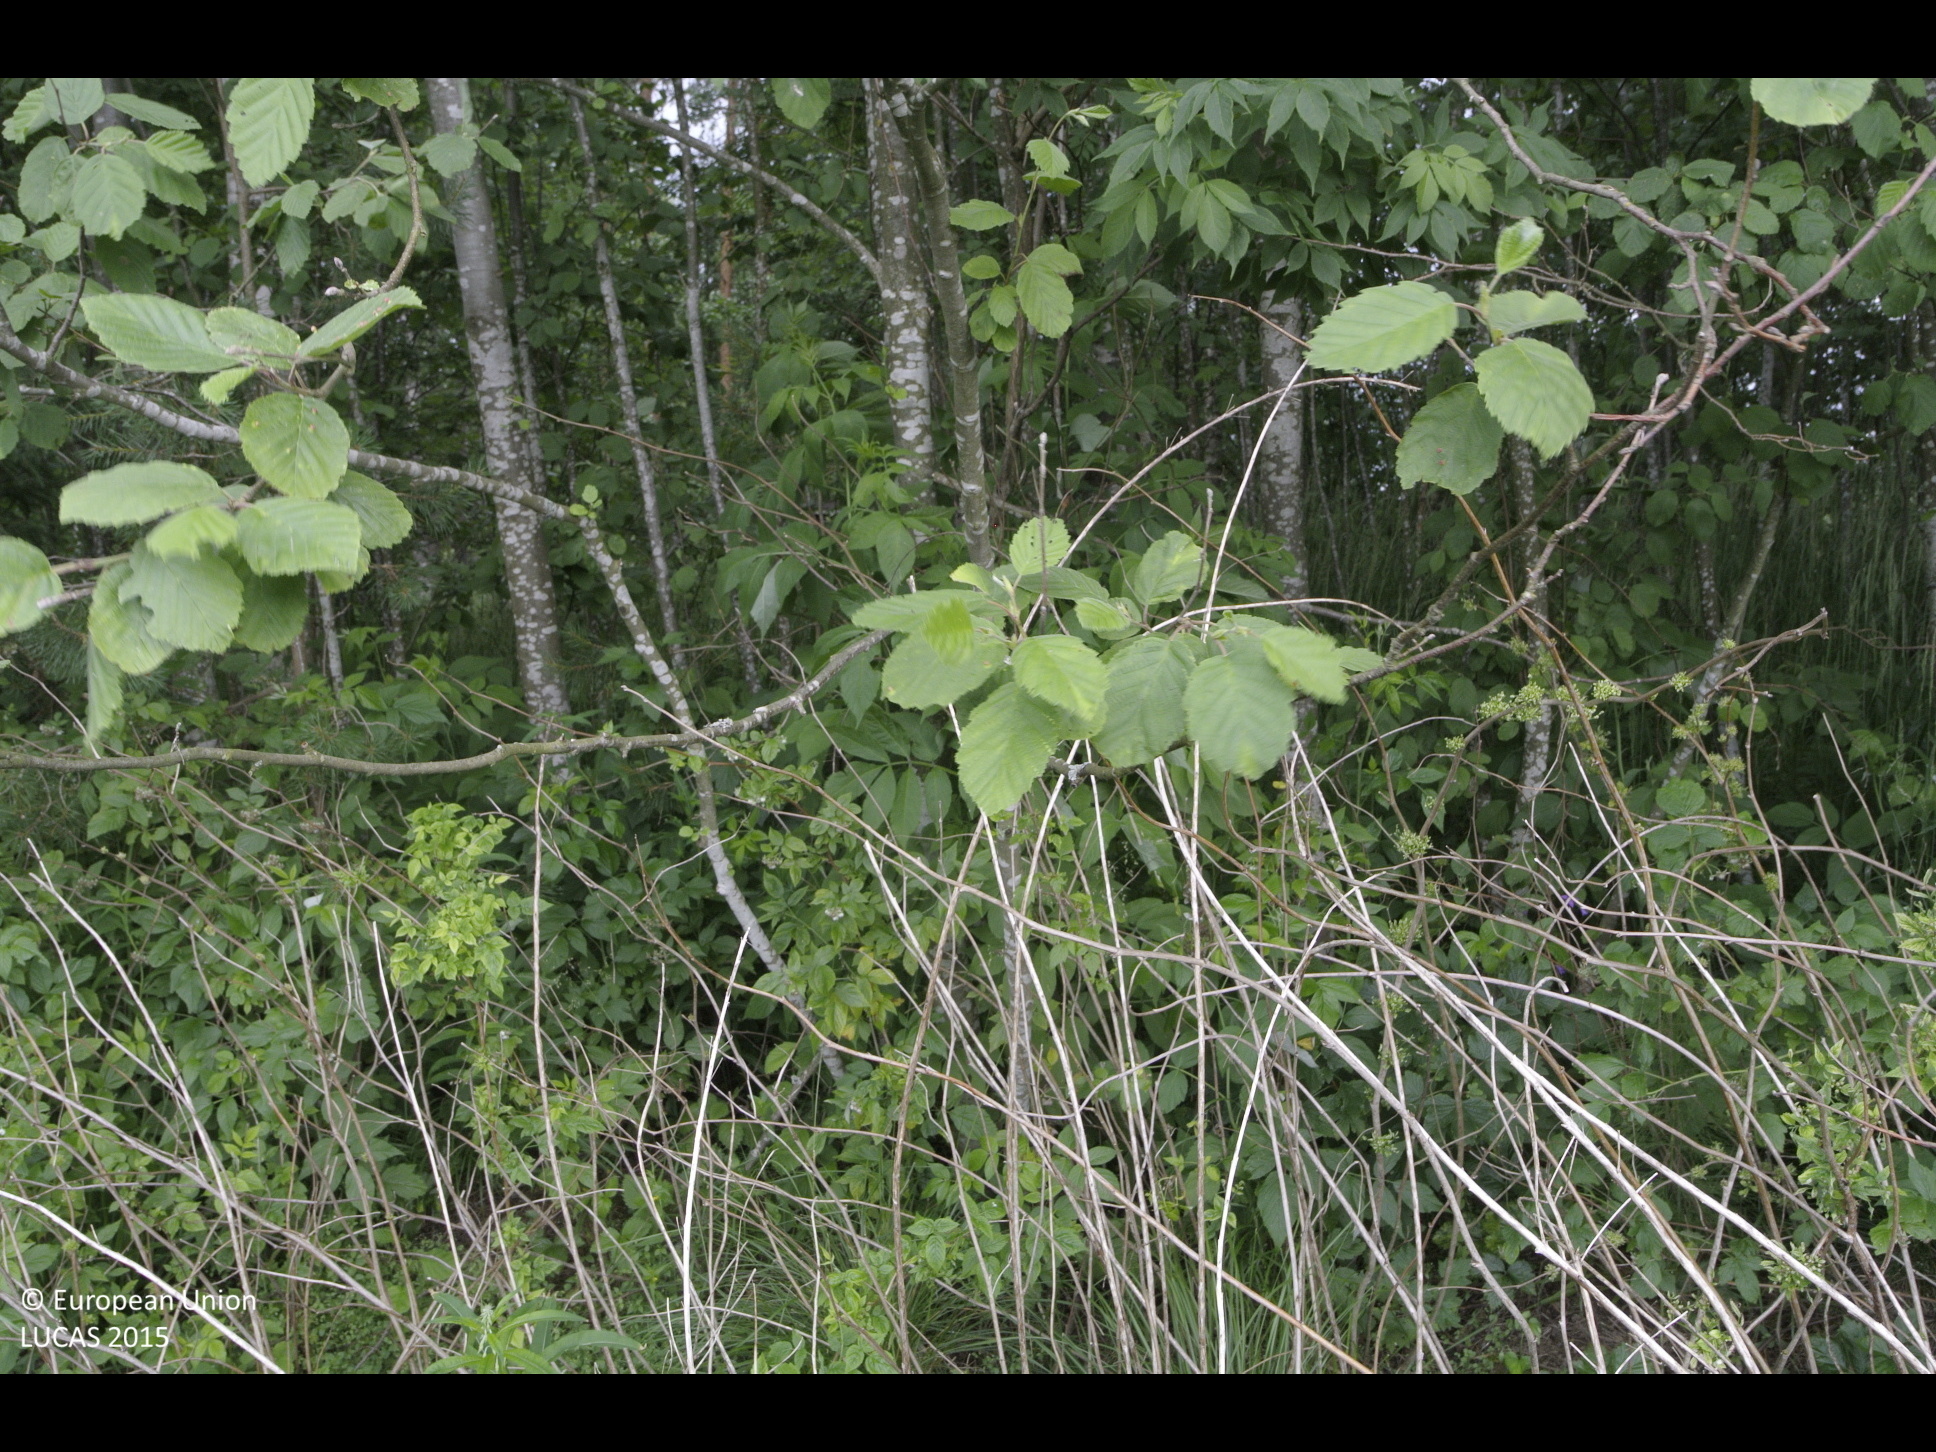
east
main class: Cropland
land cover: Common wheat
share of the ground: > 75 %
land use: Agriculture (excluding fallow land and kitchen gardens)
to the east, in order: Common wheat; Grass margins; Ditches and canals; Grass margins; Oats
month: July
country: FI
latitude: 61.3170
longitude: 25.7237
